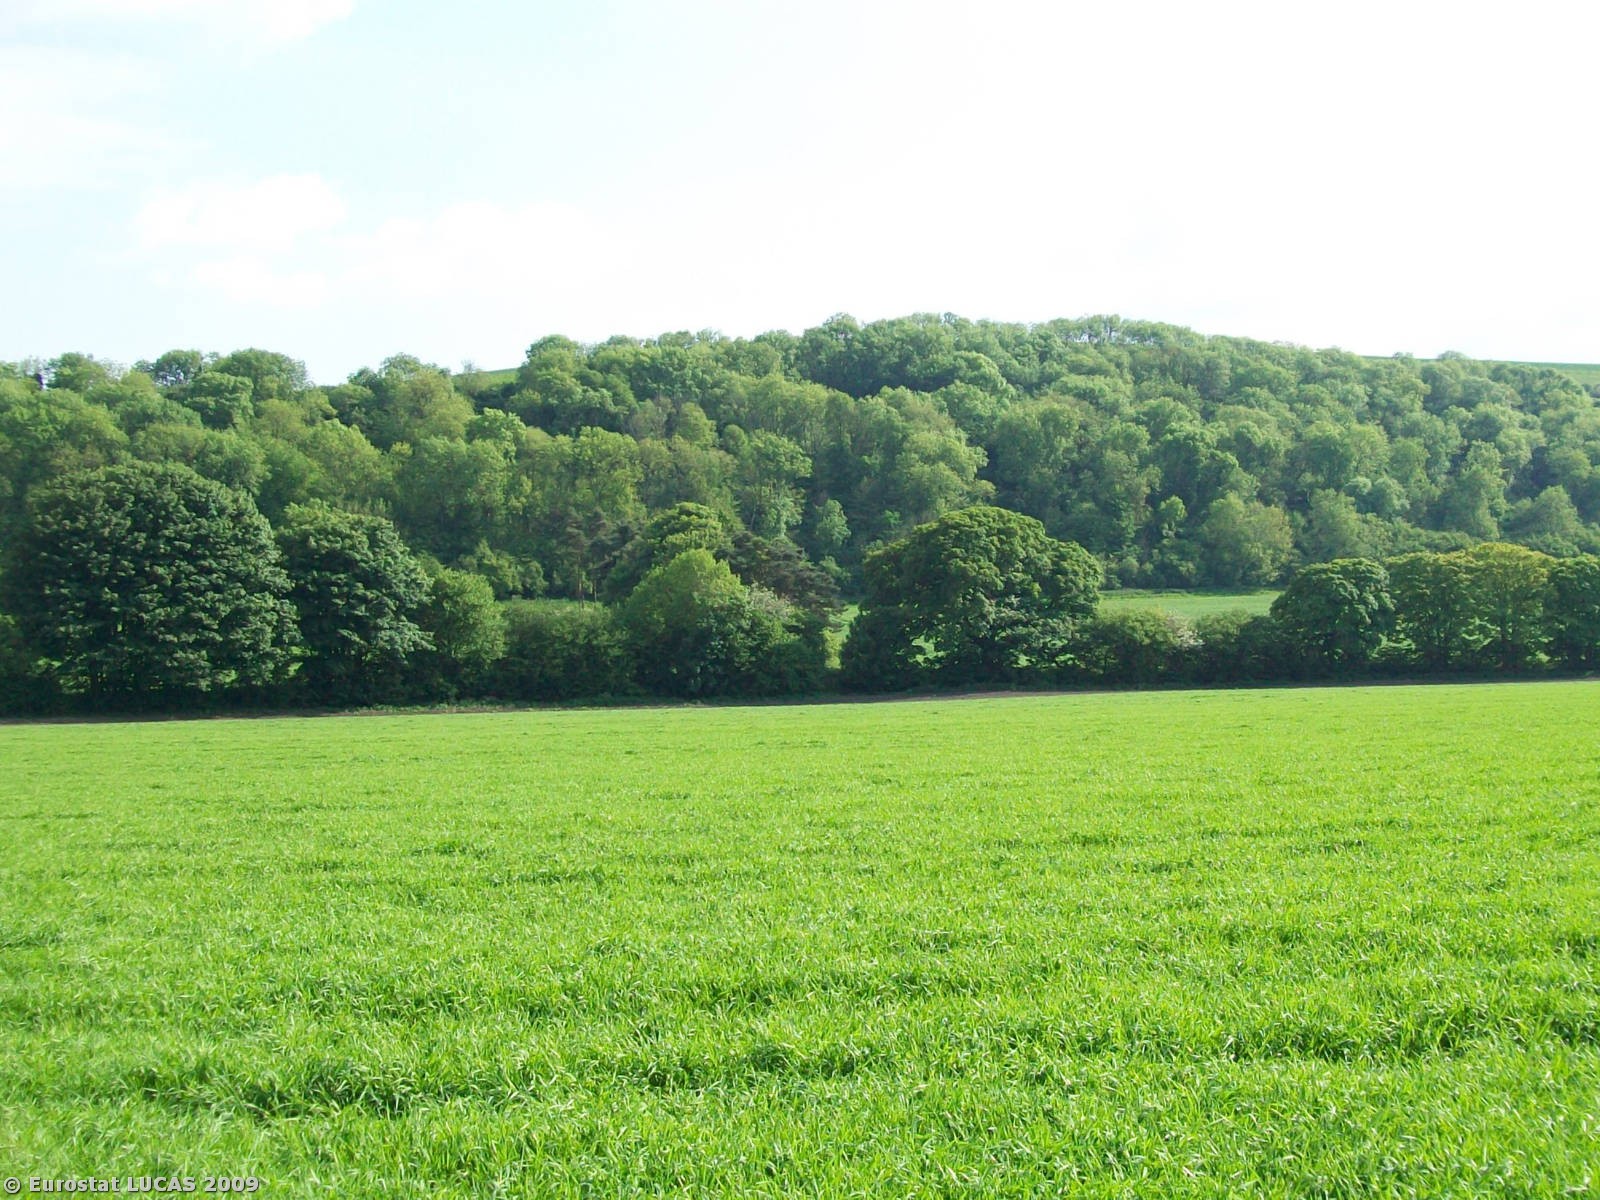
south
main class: Cropland
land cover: Barley
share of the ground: > 75 %
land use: Agriculture (excluding fallow land and kitchen gardens)
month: May
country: GB
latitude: 51.1600
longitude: -2.2305
